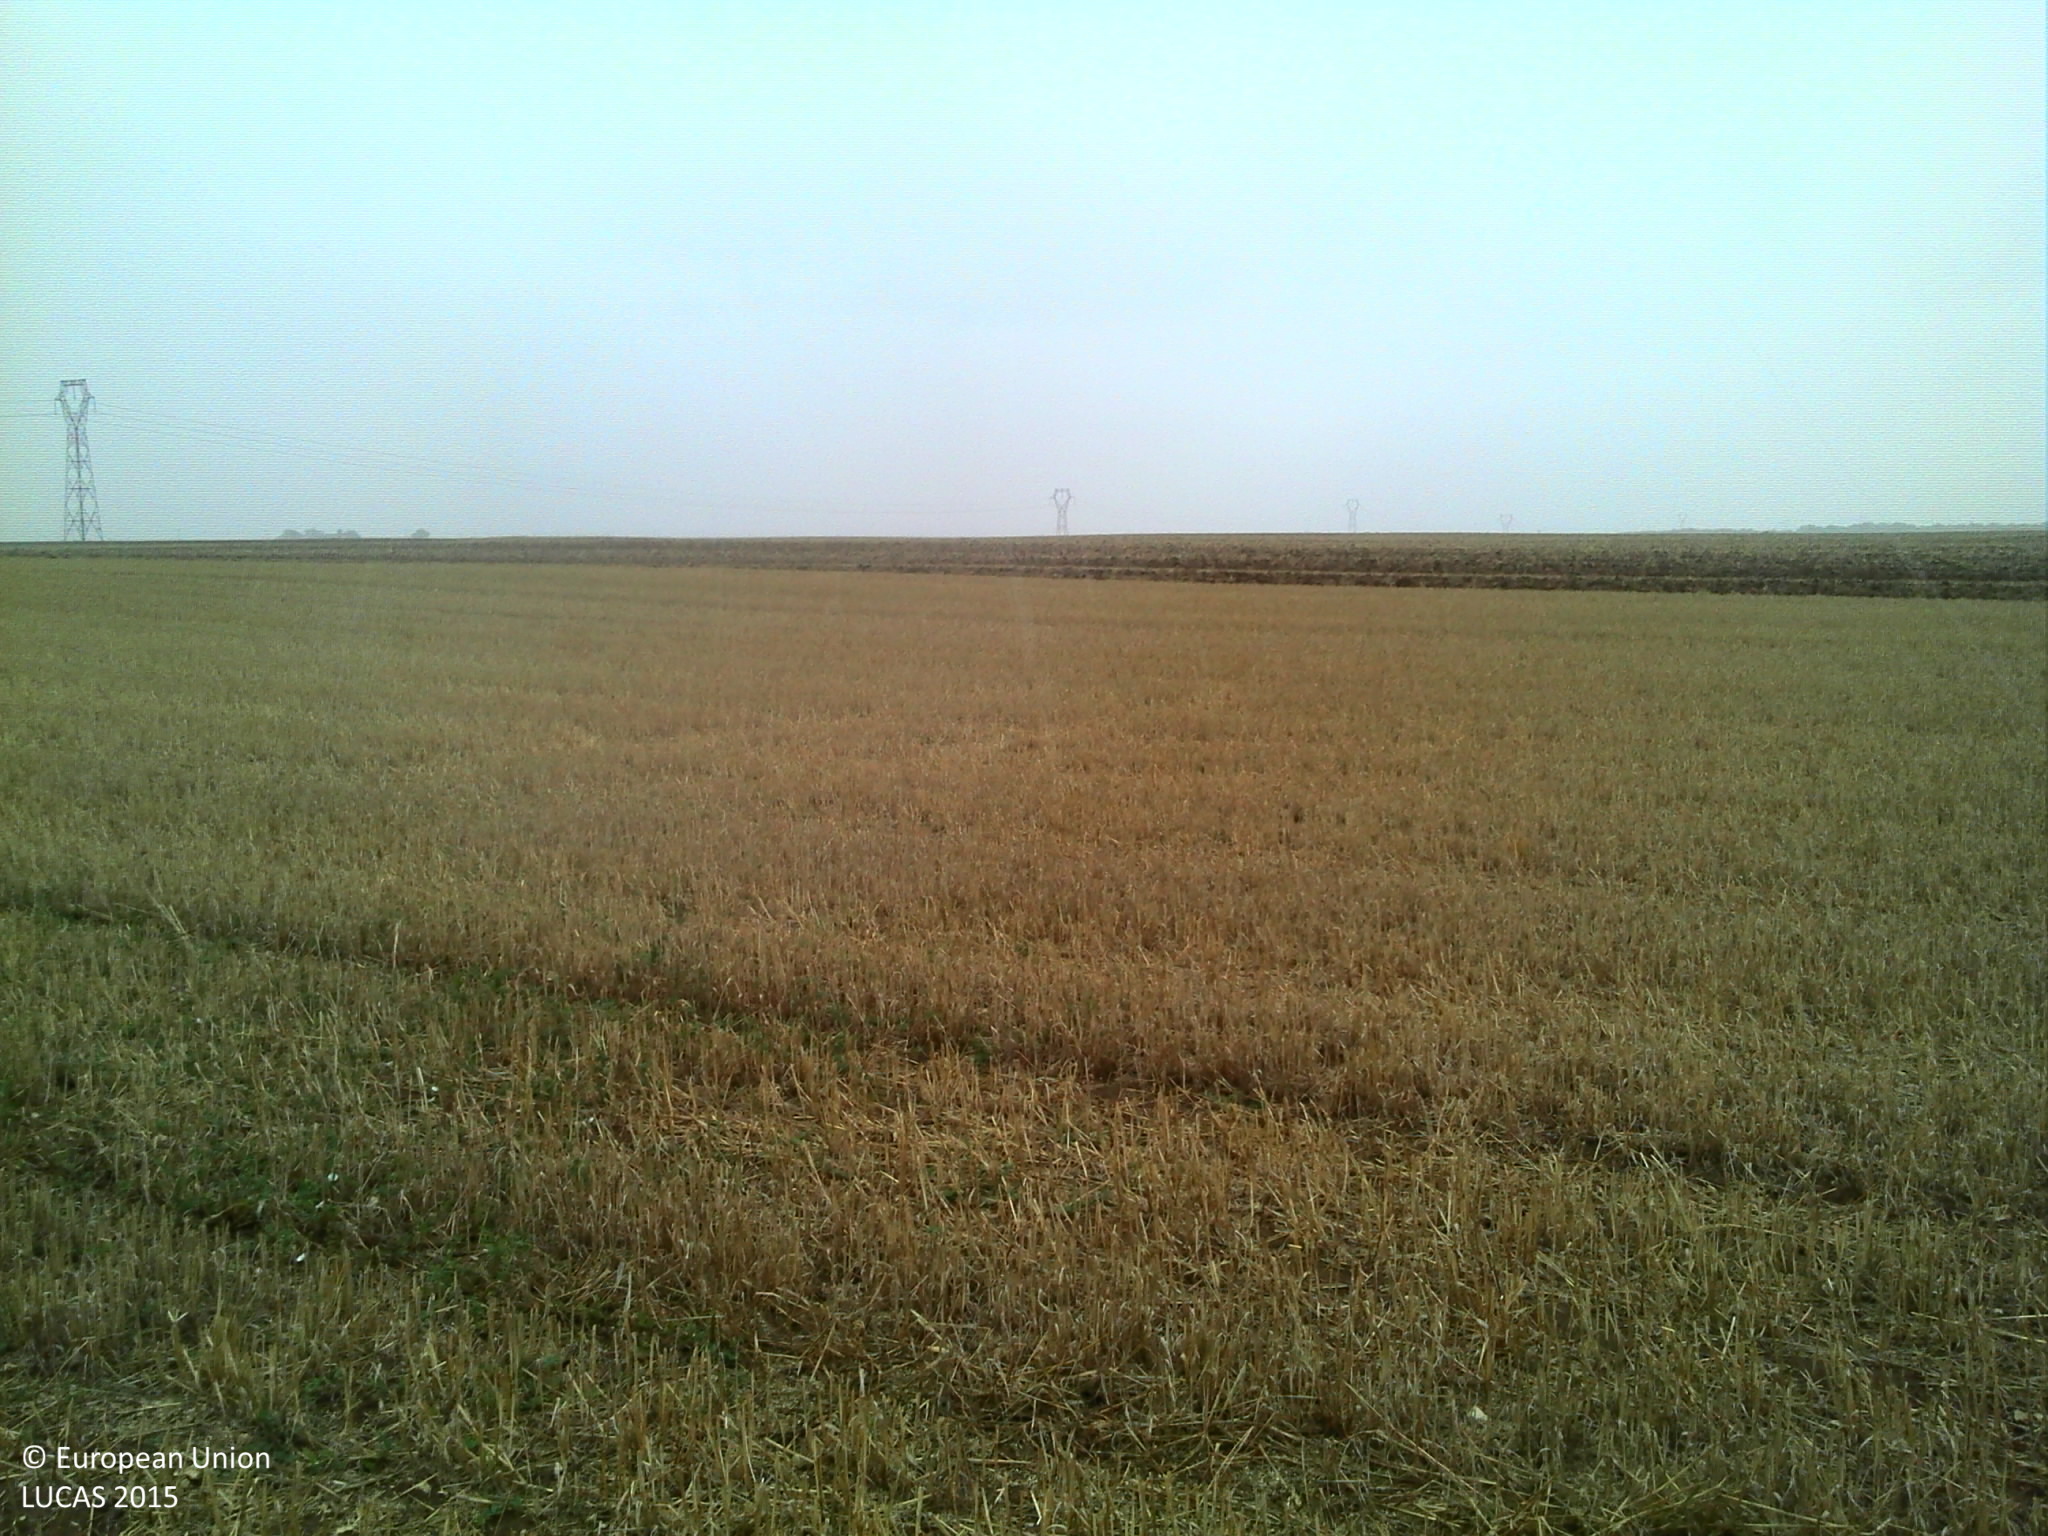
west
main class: Cropland
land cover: Common wheat
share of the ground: < 10 %
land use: Agriculture (excluding fallow land and kitchen gardens)
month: August
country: FR
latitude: 46.7478
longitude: 0.1481
